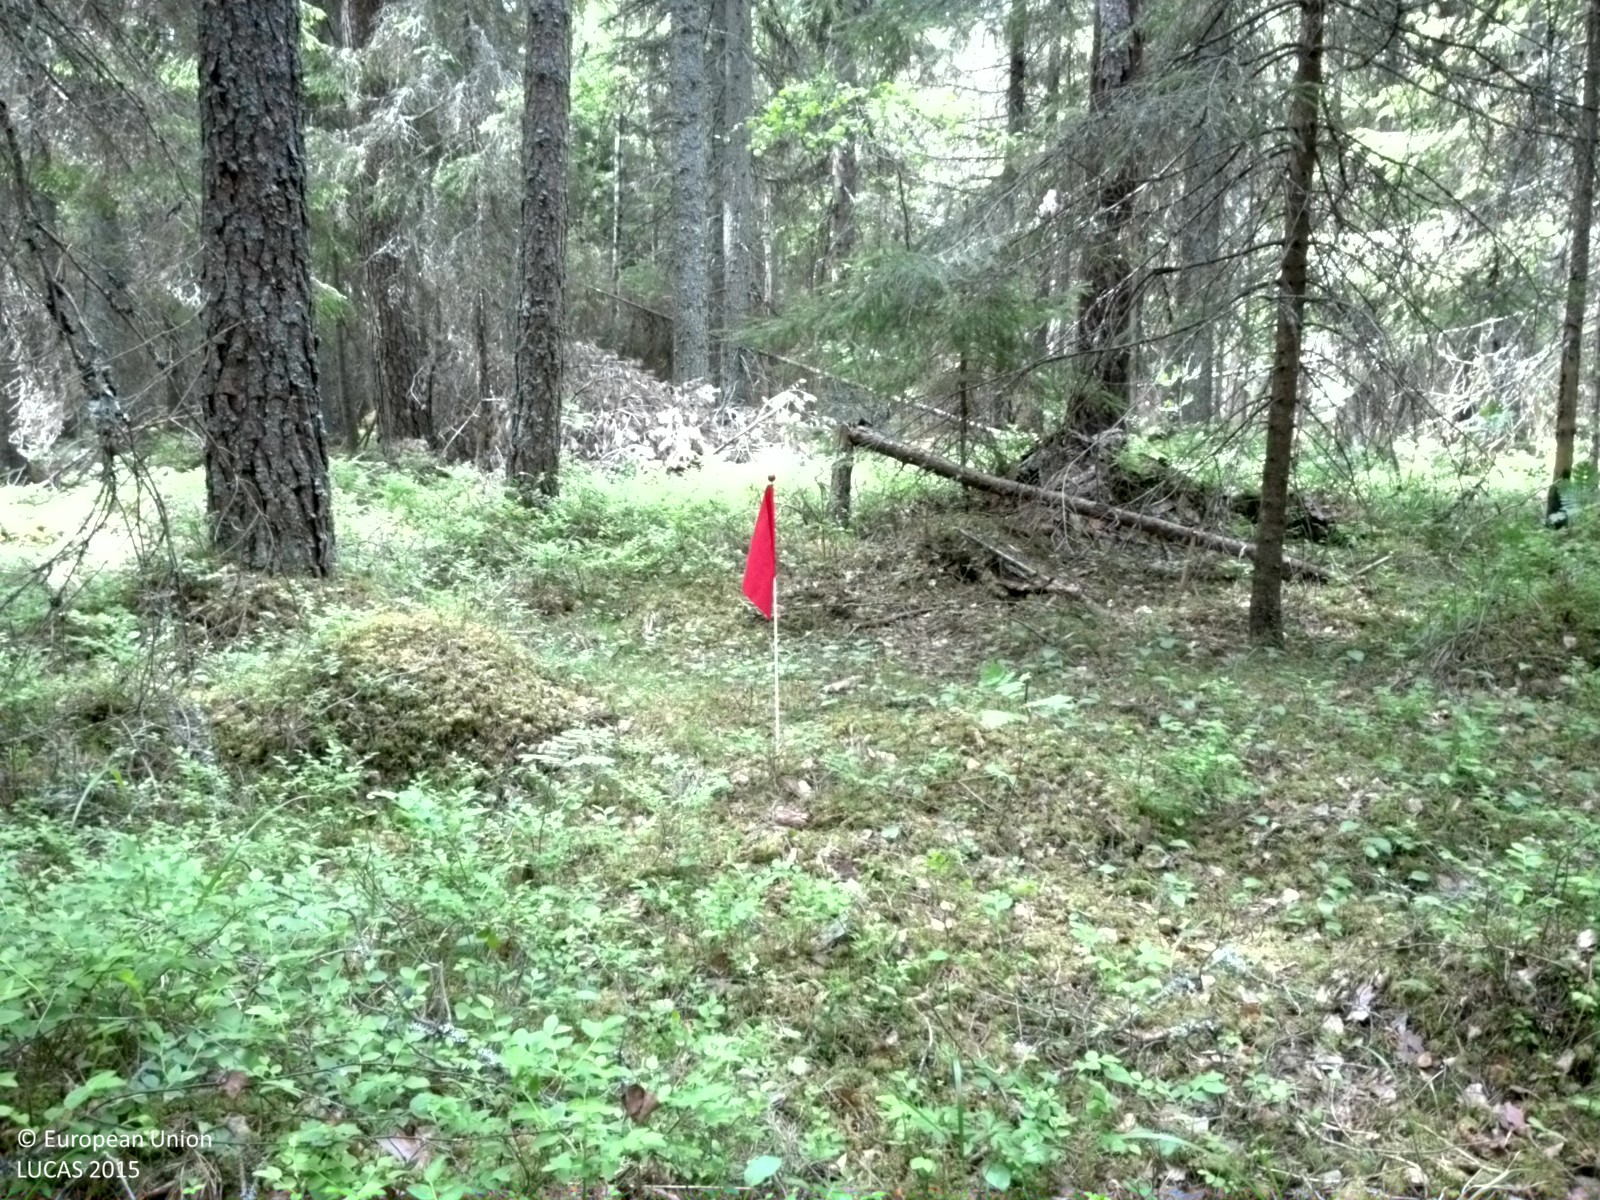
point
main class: Woodland
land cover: Spruce dominated coniferous woodland
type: boreal forest
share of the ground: > 75 %
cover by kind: coniferous forest trees 75 %, shrubs 10 %, lichens and mosses 10 %, broadleaved forest trees 5 %
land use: Forestry
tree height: > 5 m
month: June
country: SE
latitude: 60.2642
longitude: 17.2753
